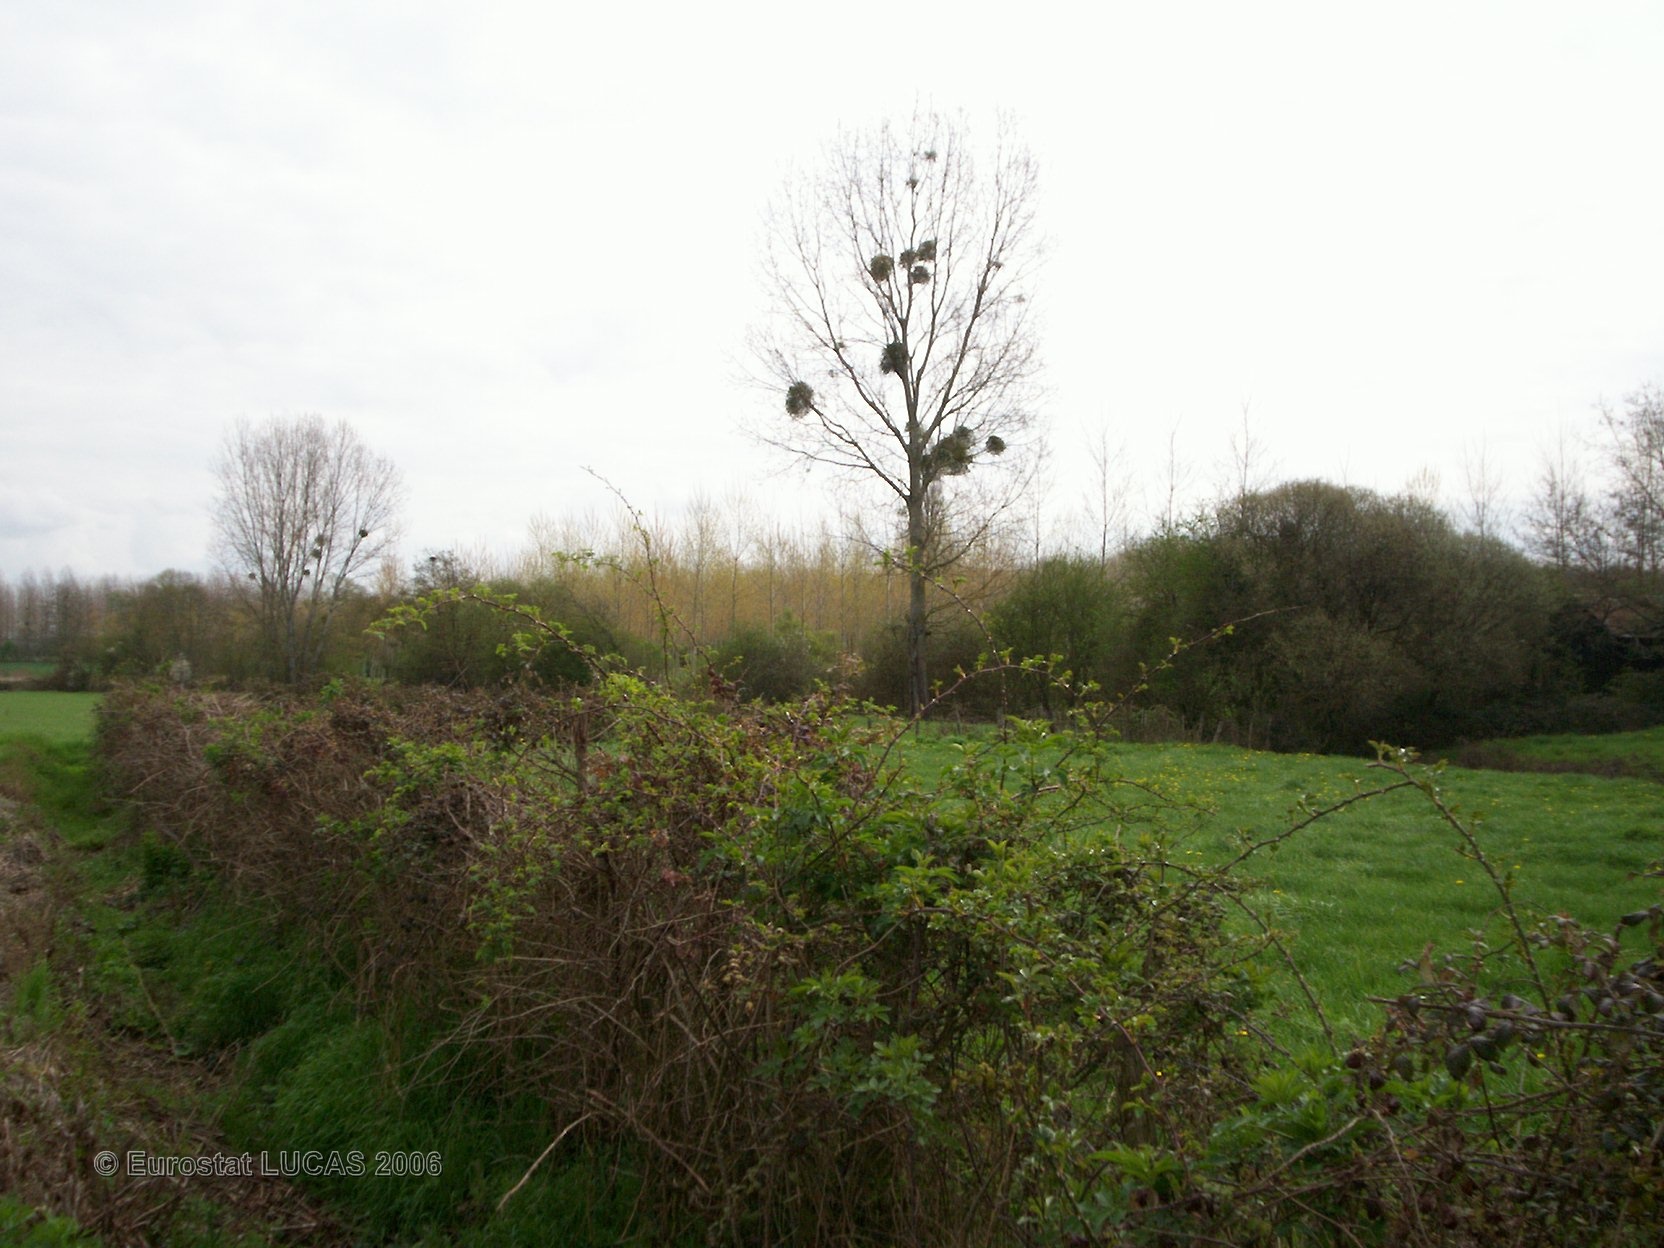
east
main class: Cropland
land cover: Sunflower
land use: Agriculture (excluding fallow land and kitchen gardens)
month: May
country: FR
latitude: 47.5261
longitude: 0.1334
